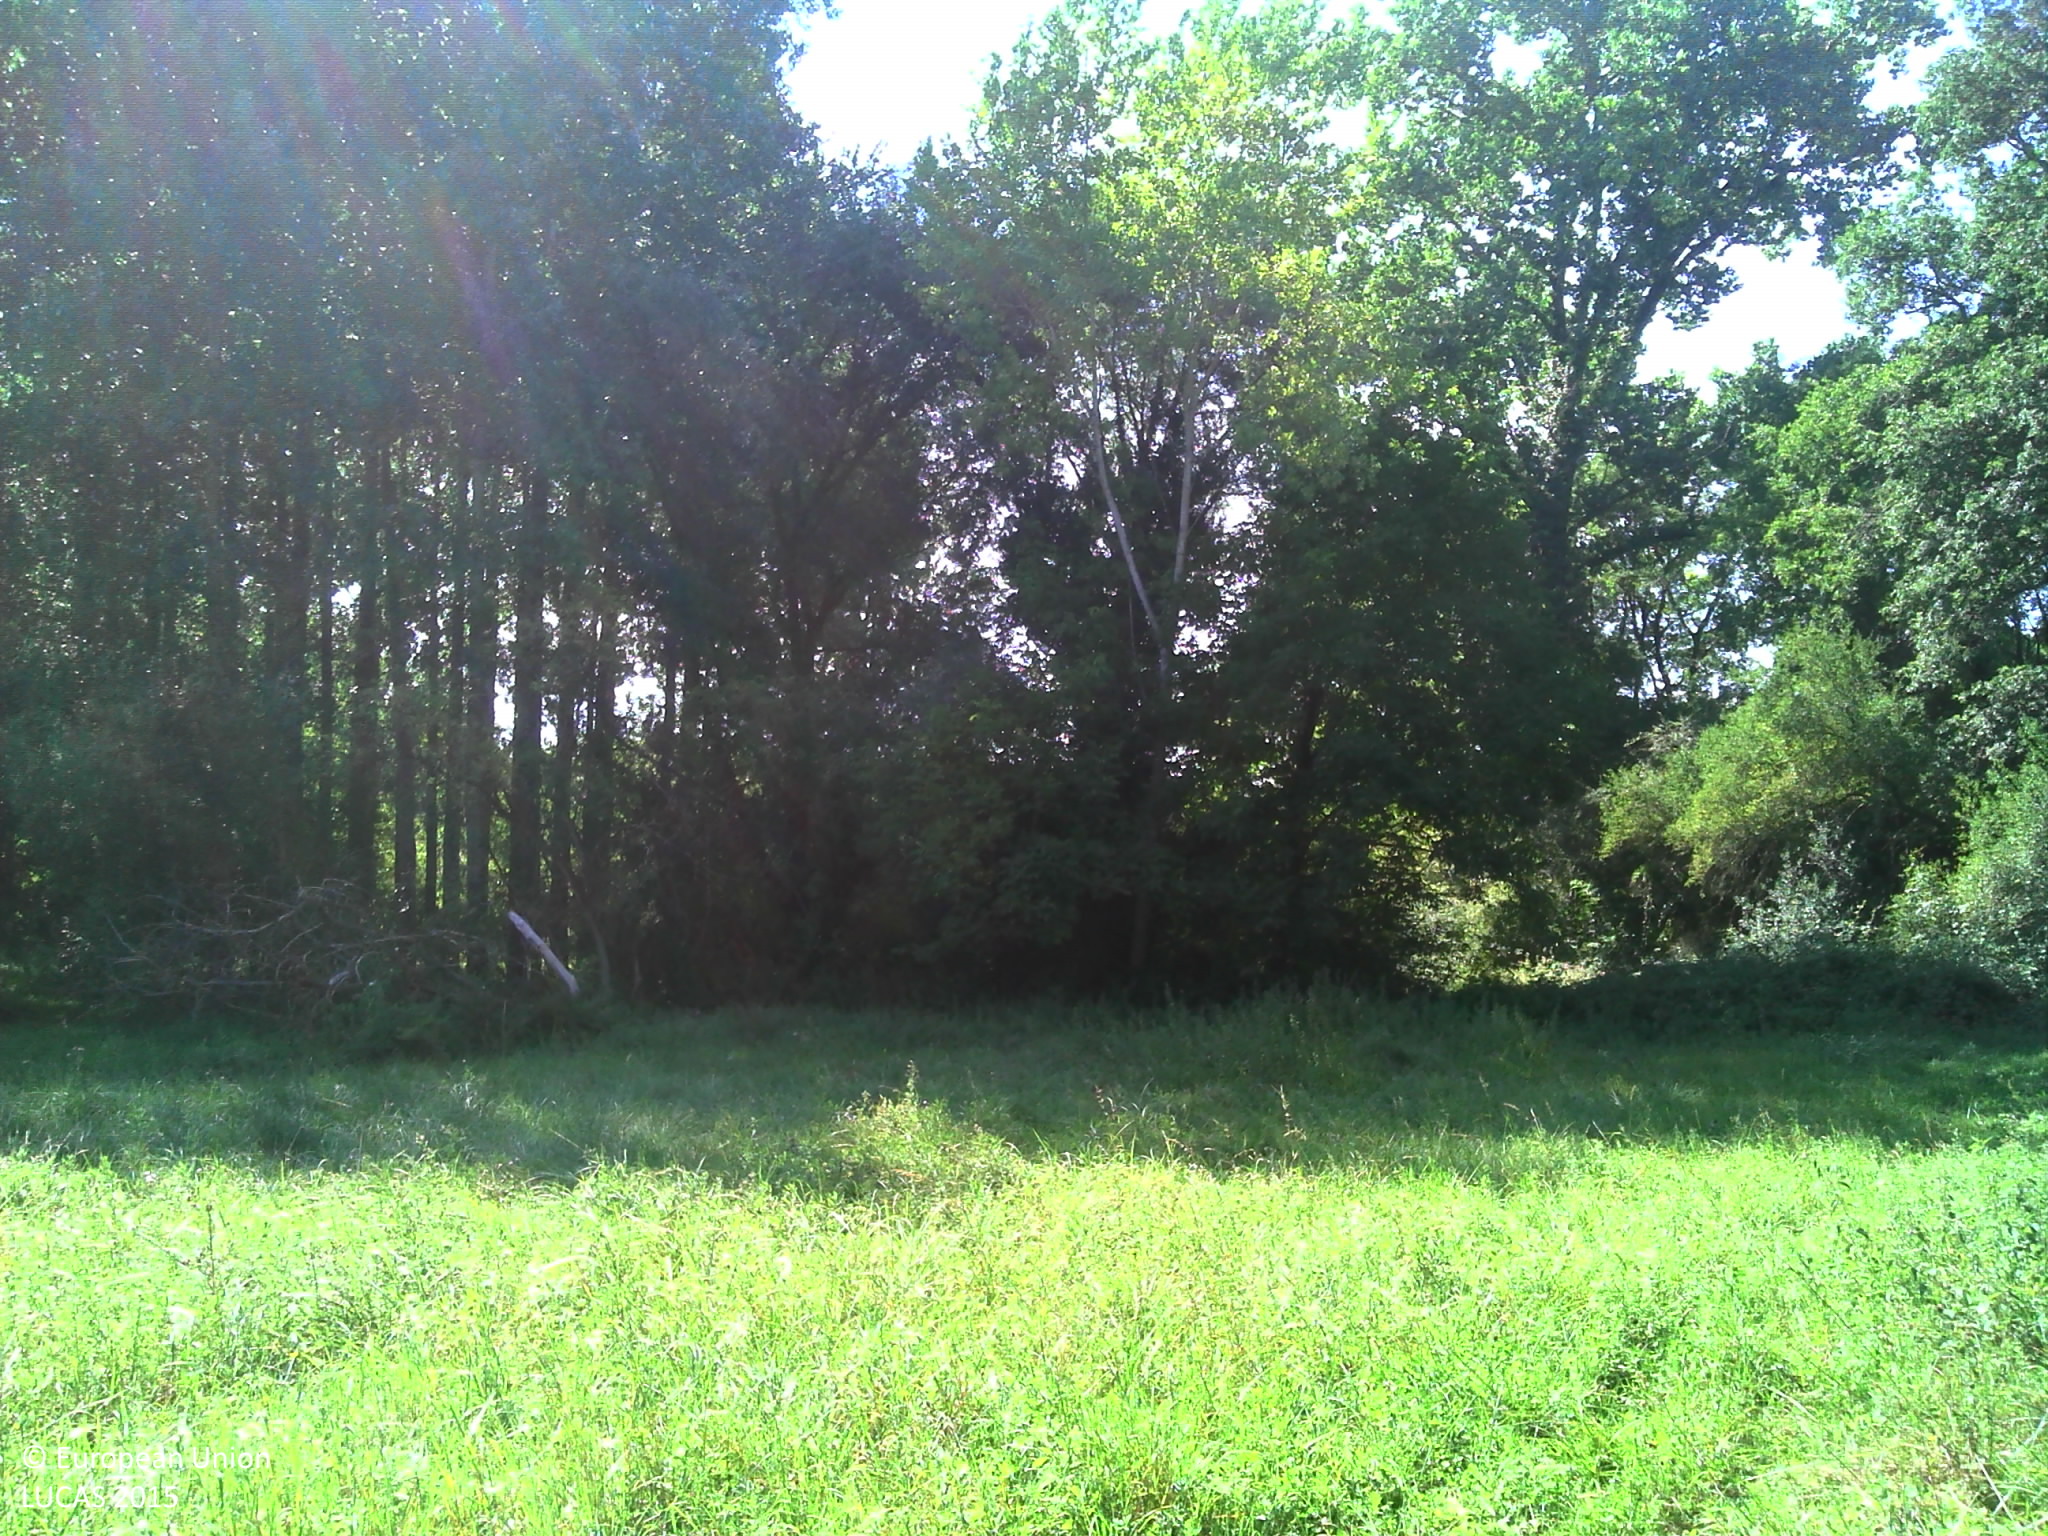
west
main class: Woodland
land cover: Broadleaved woodland
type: acidophilous oak and oak-birch forest
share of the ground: > 75 %
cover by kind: broadleaved forest trees 40 %, shrubs 30 %, herbaceous plants 20 %, unconsolidated bare surface 10 %
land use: Forestry
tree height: > 5 m
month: August
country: FR
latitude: 45.3943
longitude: 0.4194
